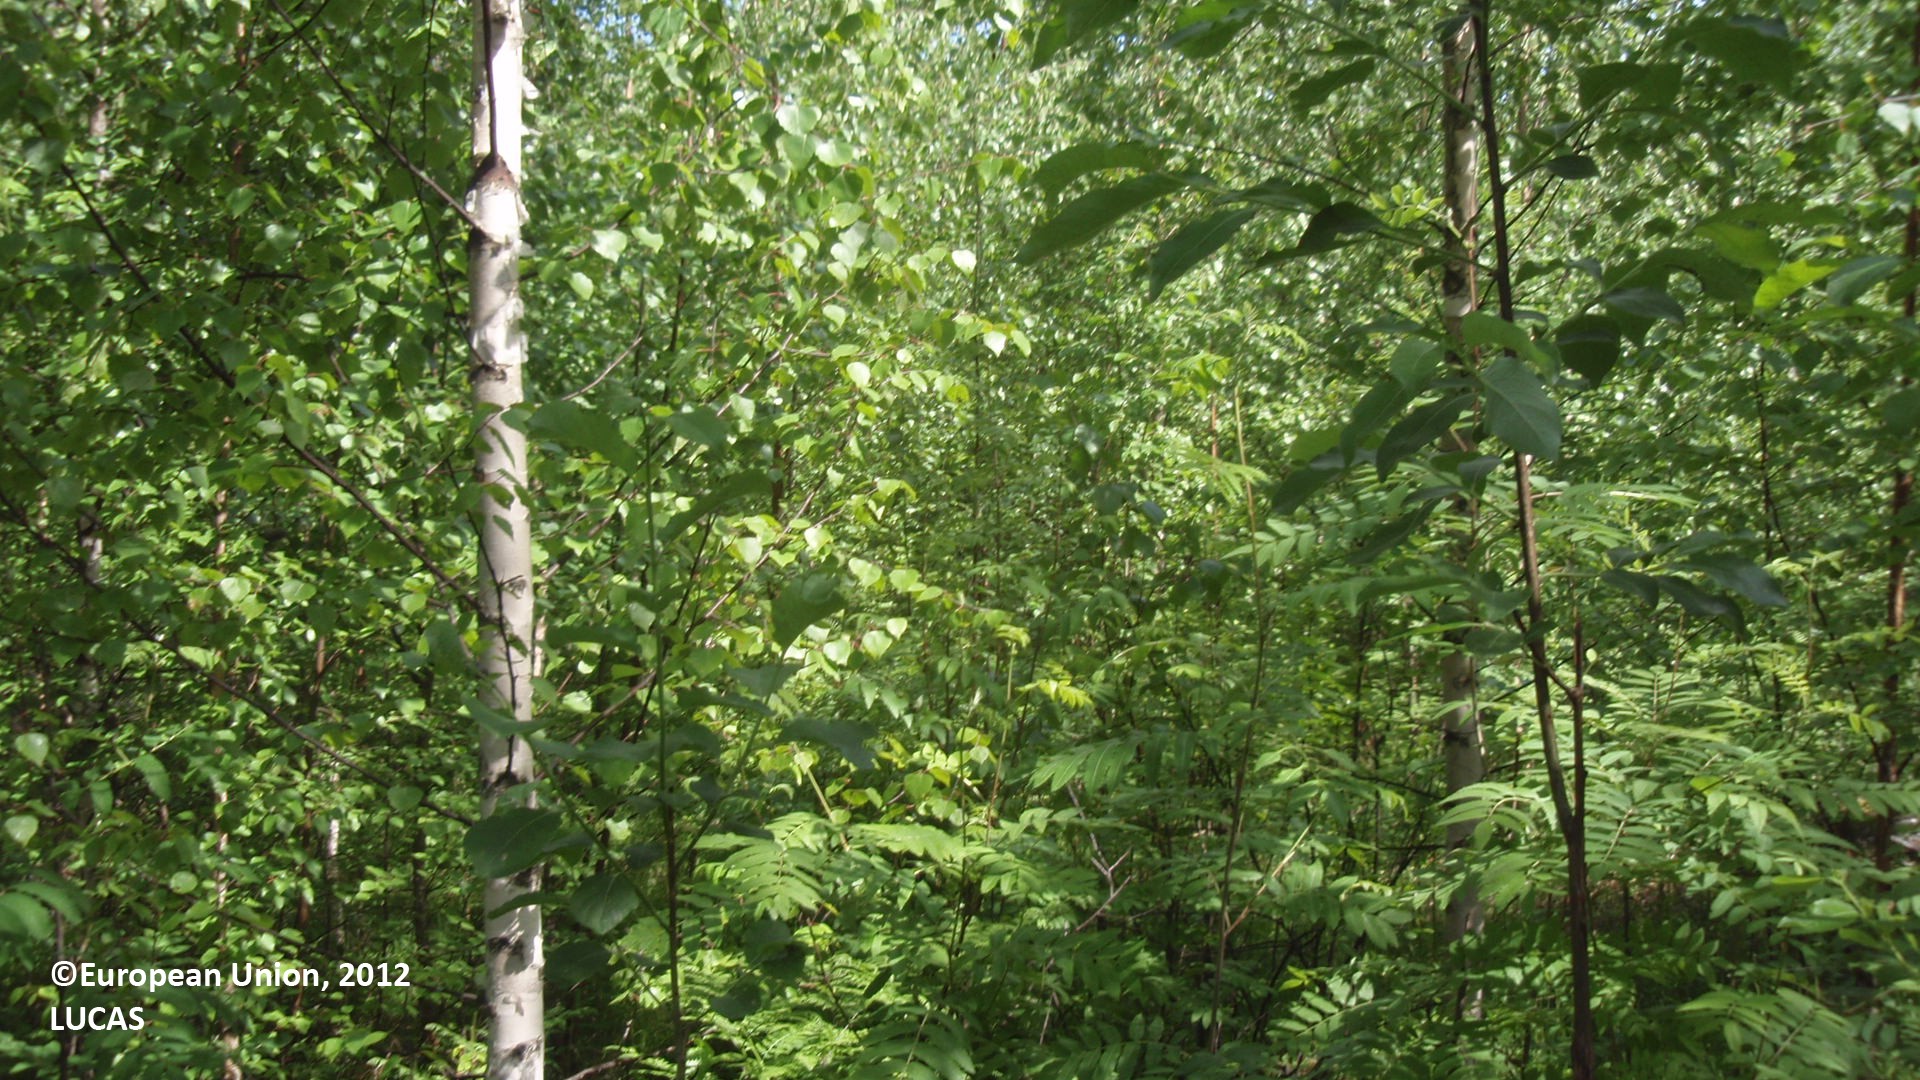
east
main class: Woodland
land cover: Broadleaved woodland
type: non-riverine alder, birch or aspen forest
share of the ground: > 75 %
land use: Forestry
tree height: < 5 m
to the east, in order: Broadleaved woodland; Tracks; Broadleaved woodland; Grassland without tree/shrub cover; Paved roads, cycling and walking lanes; Other mixed woodland; Grassland without tree/shrub cover; Other mixed woodland
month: June
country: FI
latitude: 61.6623
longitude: 28.4319
